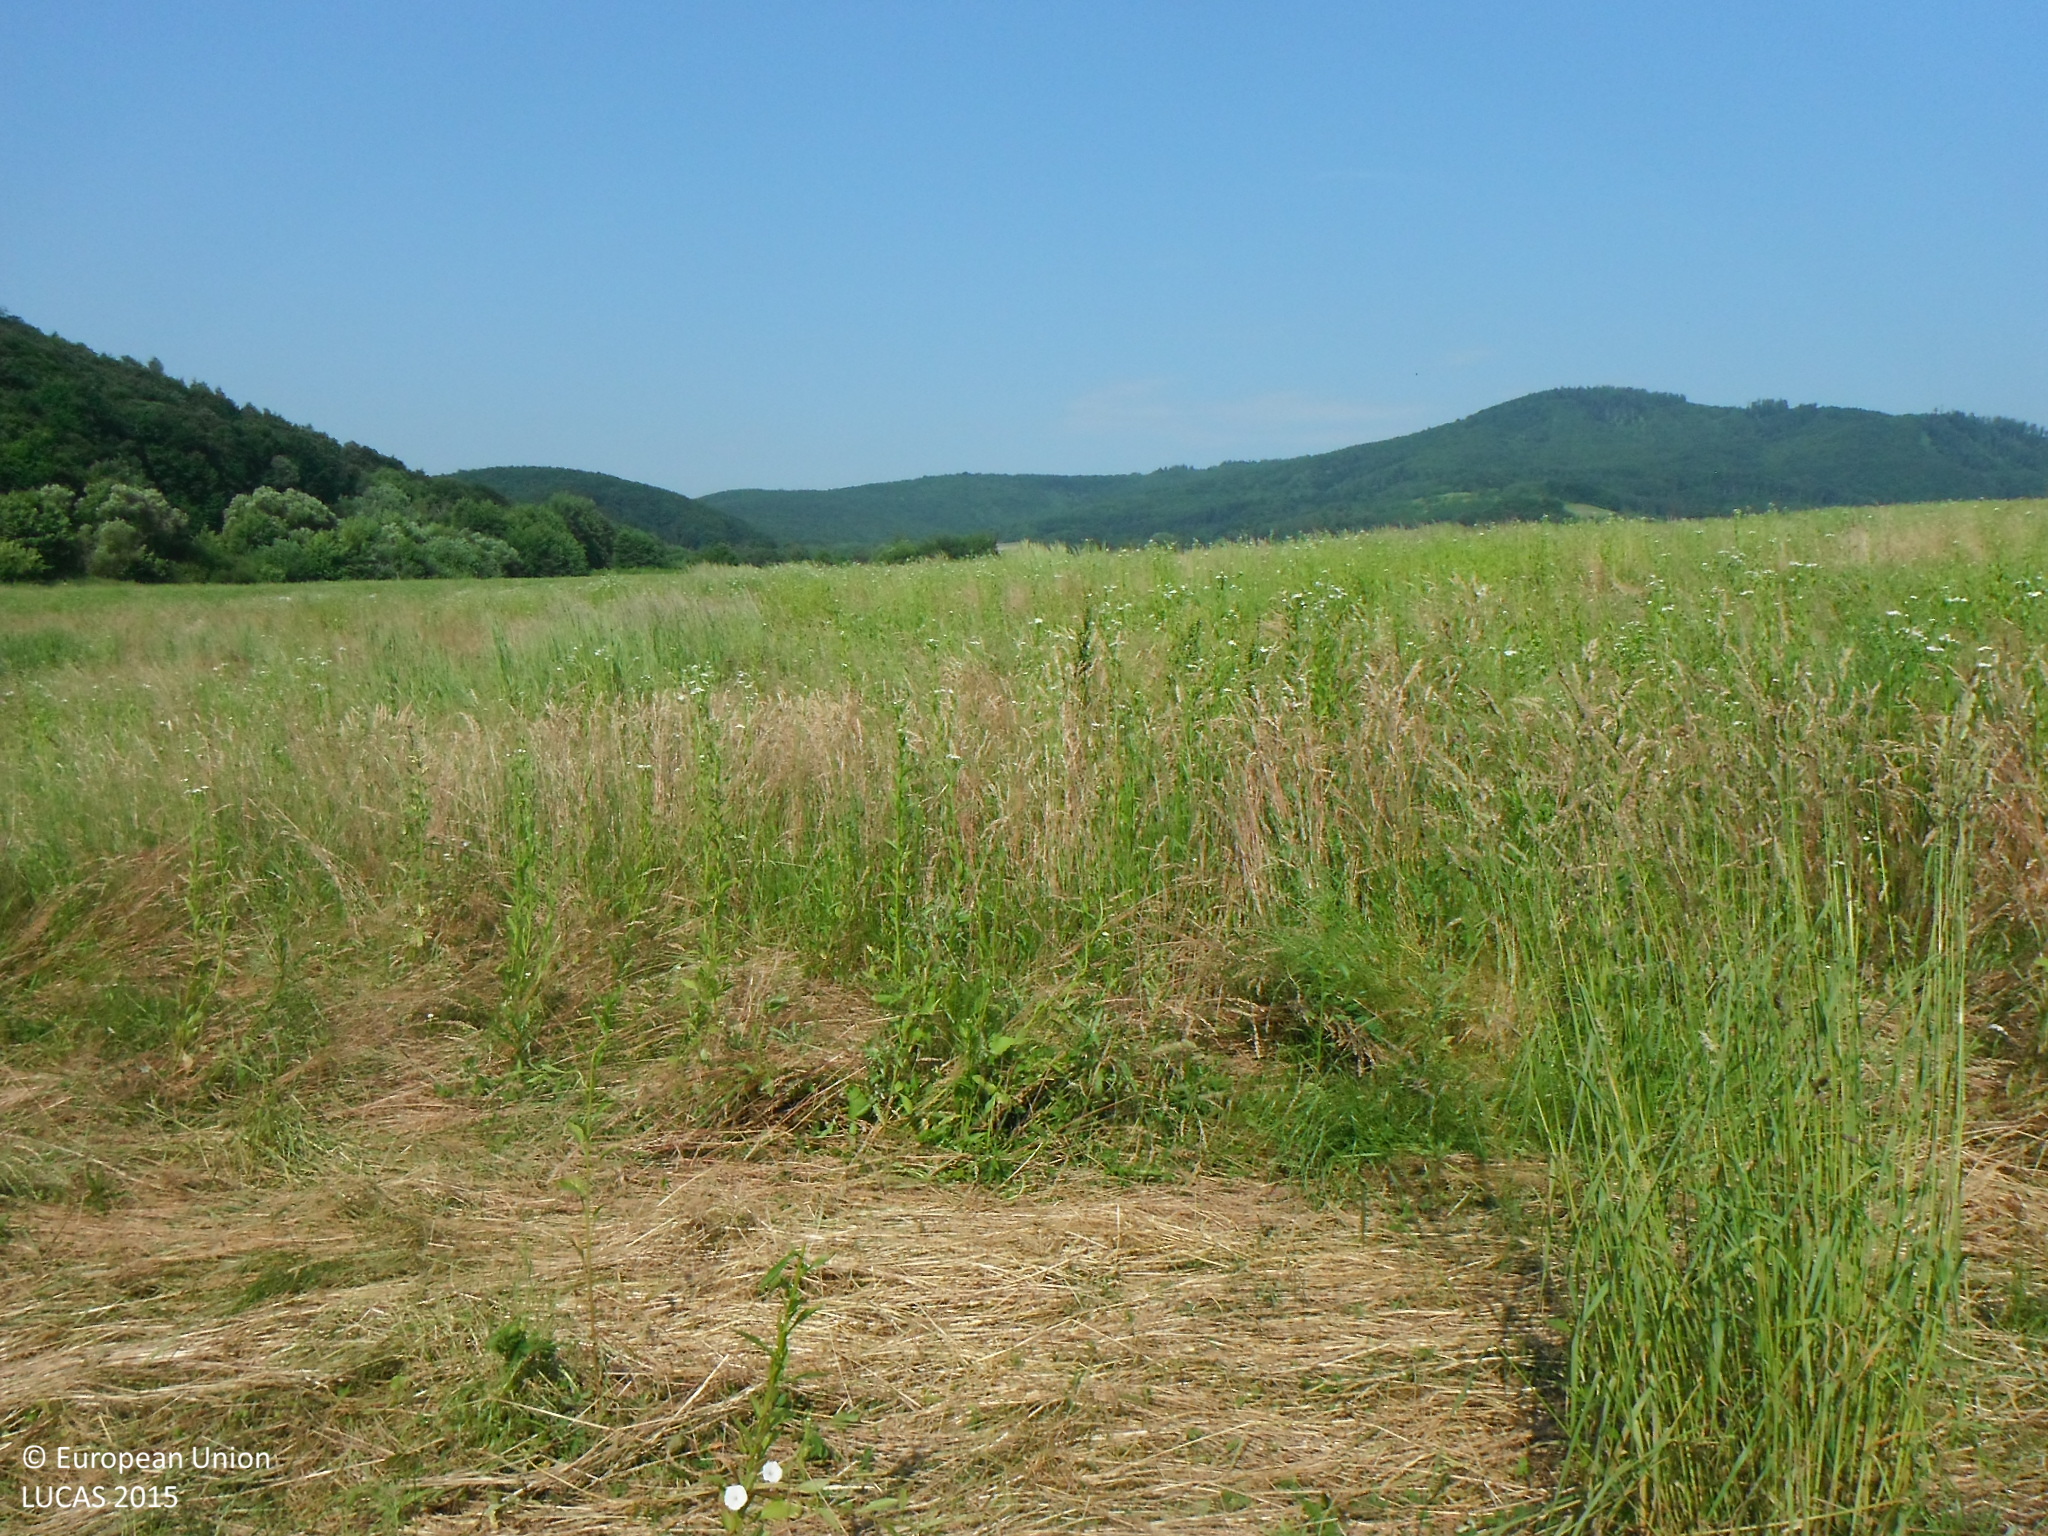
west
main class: Grassland
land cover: Spontaneously vegetated surfaces
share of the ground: > 75 %
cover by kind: herbaceous plants 100 %
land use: Fallow land
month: June
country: SK
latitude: 48.4656
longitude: 19.6966
